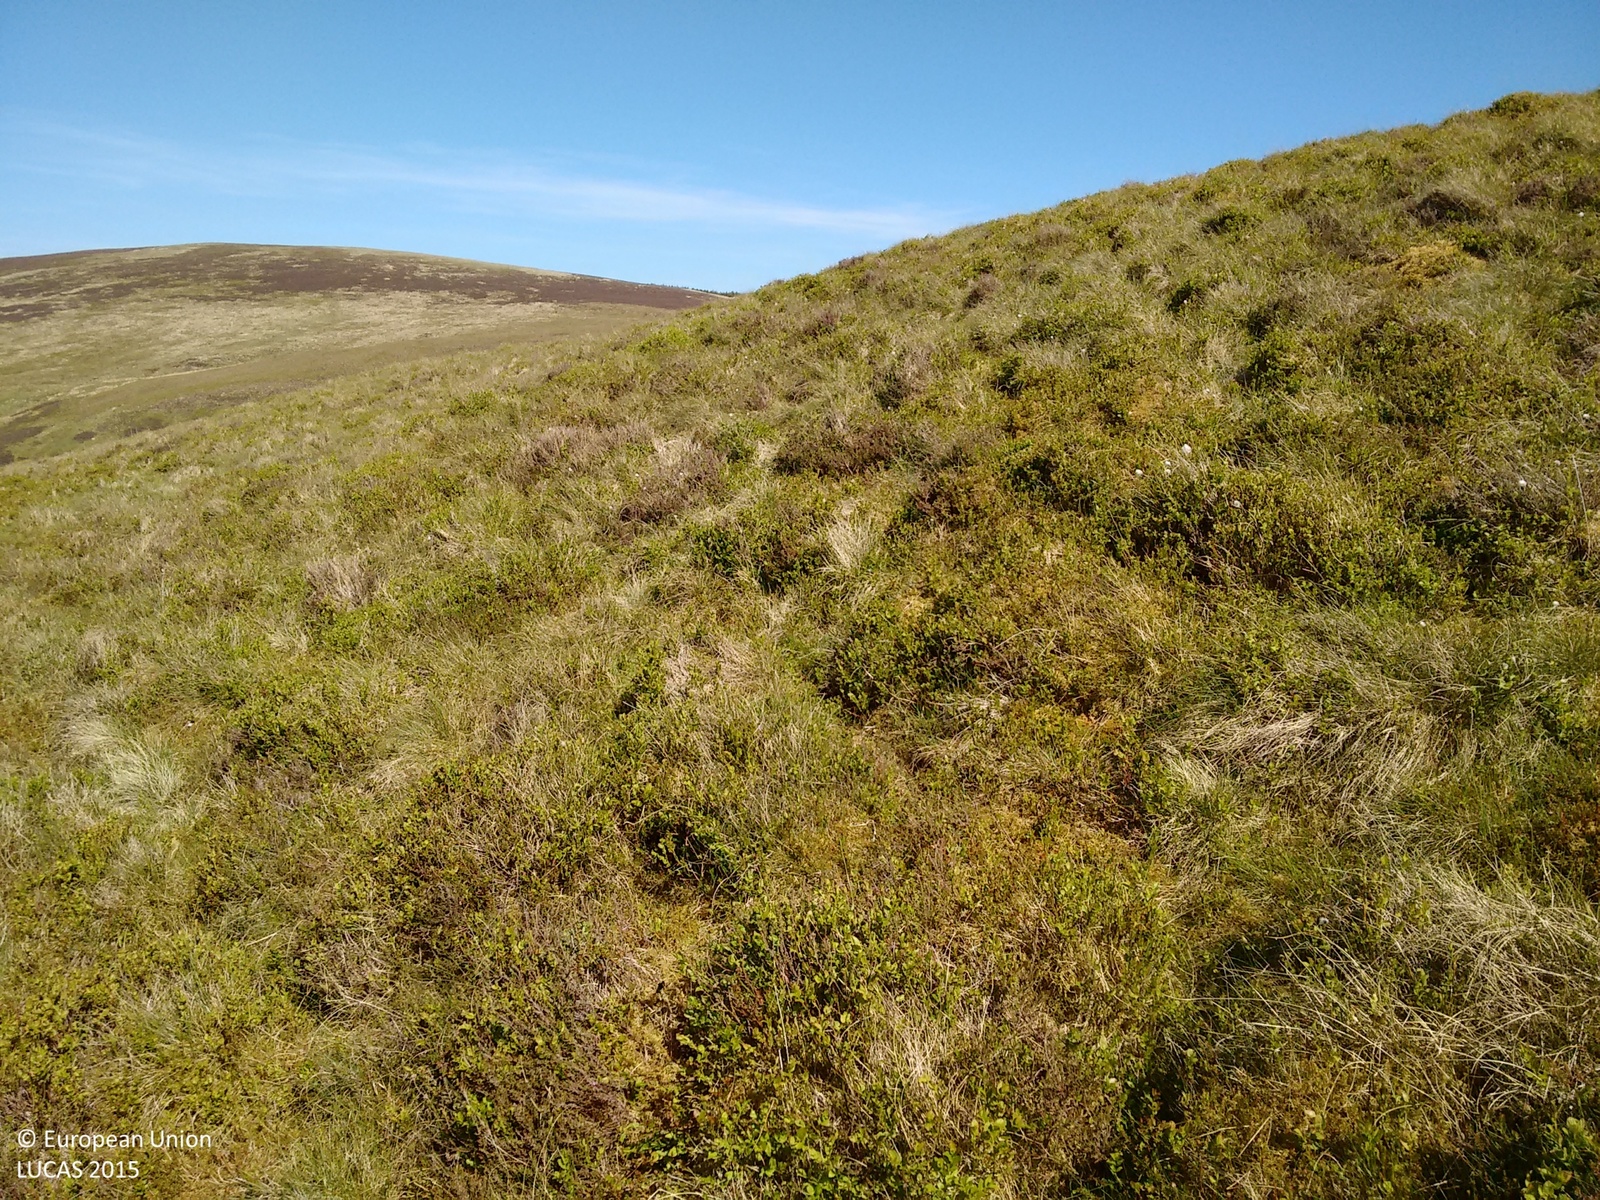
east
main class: Shrubland
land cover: Shrubland without tree cover
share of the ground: 25 - 50 %
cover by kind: shrubs 45 %, herbaceous plants 45 %, lichens and mosses 10 %
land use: Semi-natural and natural areas not in use
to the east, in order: Shrubland without tree cover
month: June
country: GB
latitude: 55.5109
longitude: -3.4588
